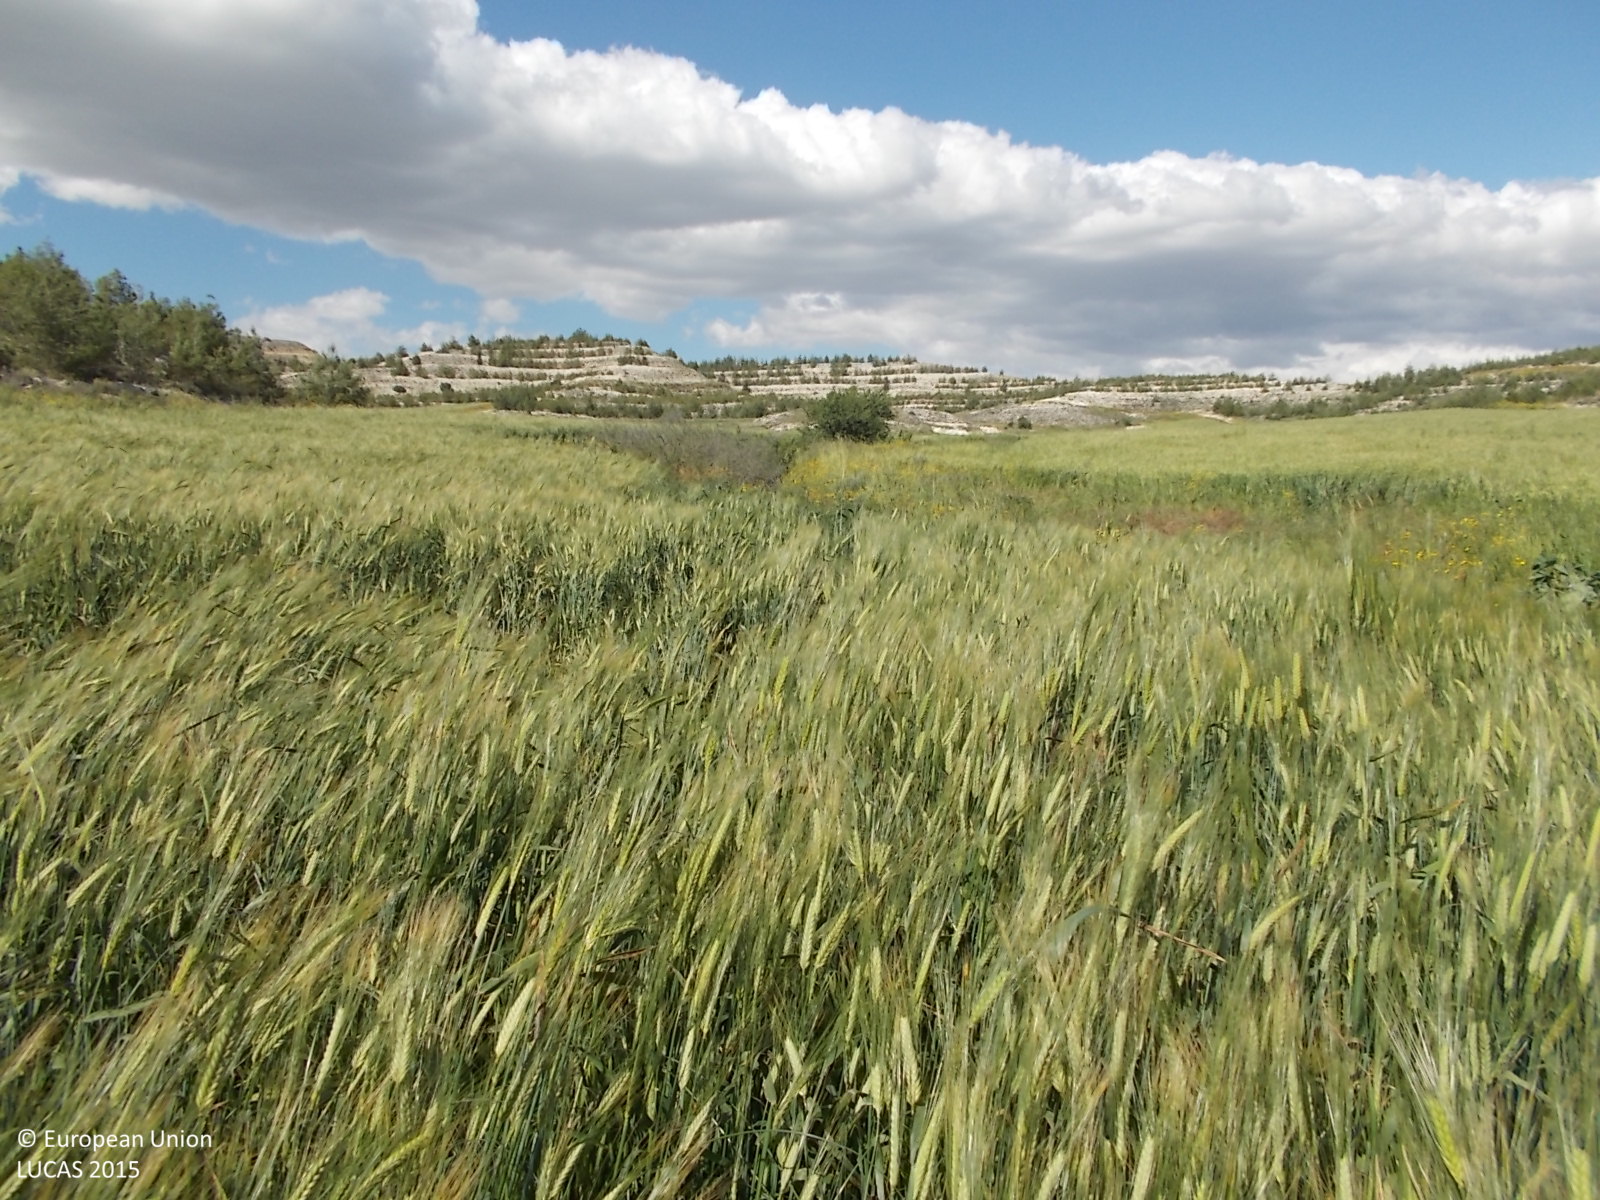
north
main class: Cropland
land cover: Barley
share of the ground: > 75 %
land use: Agriculture (excluding fallow land and kitchen gardens)
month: April
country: CY
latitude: 34.9971
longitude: 33.5208
